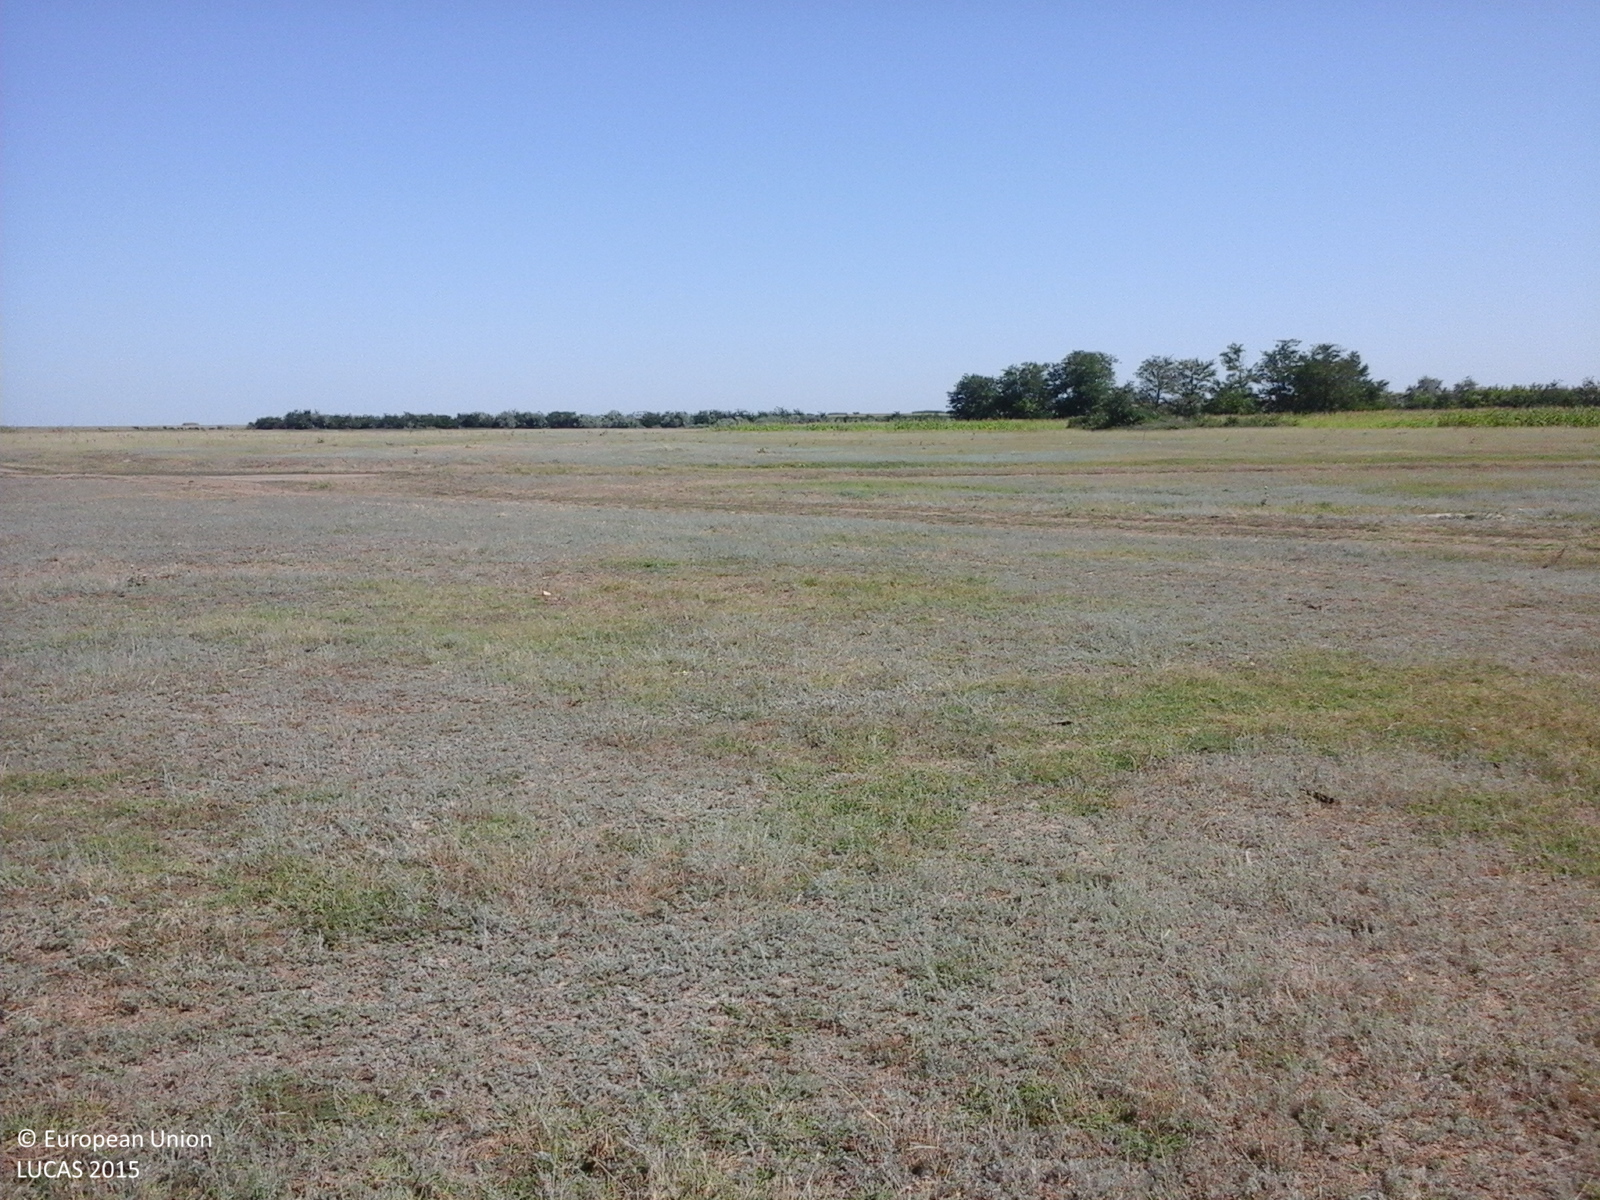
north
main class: Grassland
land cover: Grassland without tree/shrub cover
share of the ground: > 75 %
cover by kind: herbaceous plants 100 %
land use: Agriculture (excluding fallow land and kitchen gardens)
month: August
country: RO
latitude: 44.6290
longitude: 28.1772
